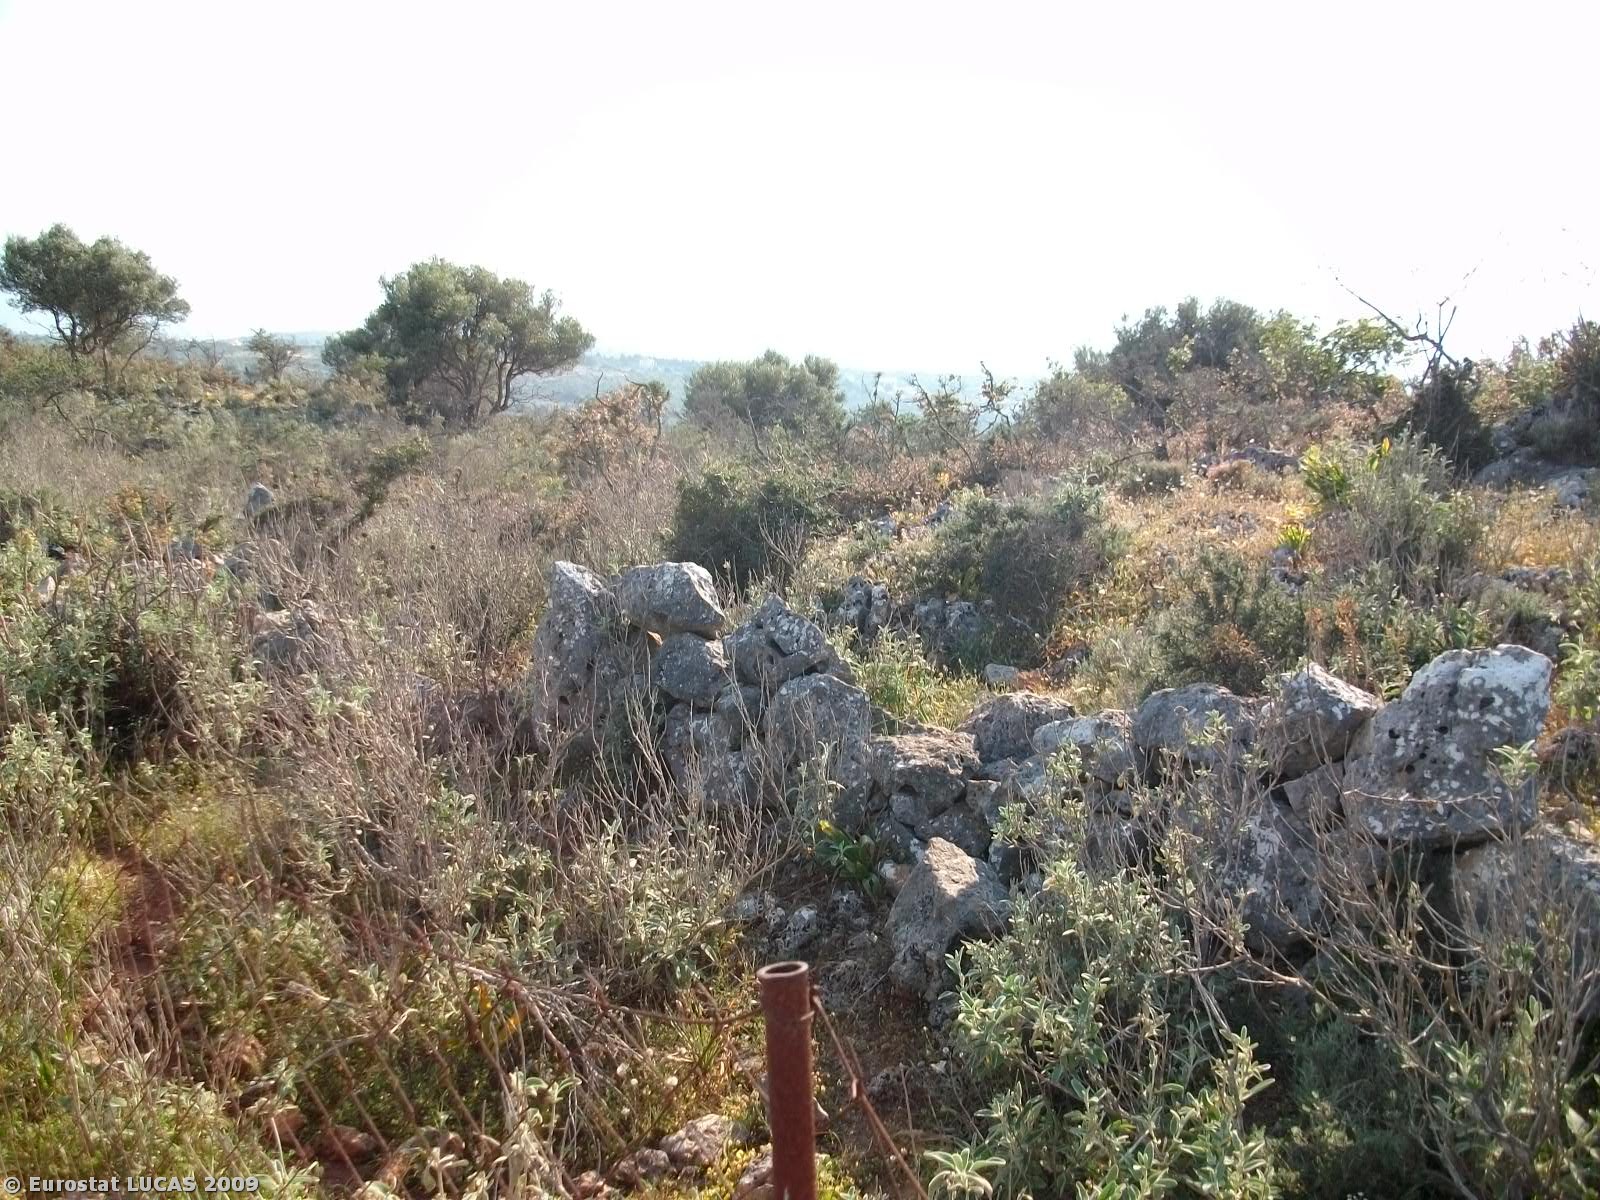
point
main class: Shrubland
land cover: Shrubland with sparse tree cover
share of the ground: > 75 %
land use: Agriculture (excluding fallow land and kitchen gardens)
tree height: > 5 m
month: May
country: GR
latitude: 35.4209
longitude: 24.2265
